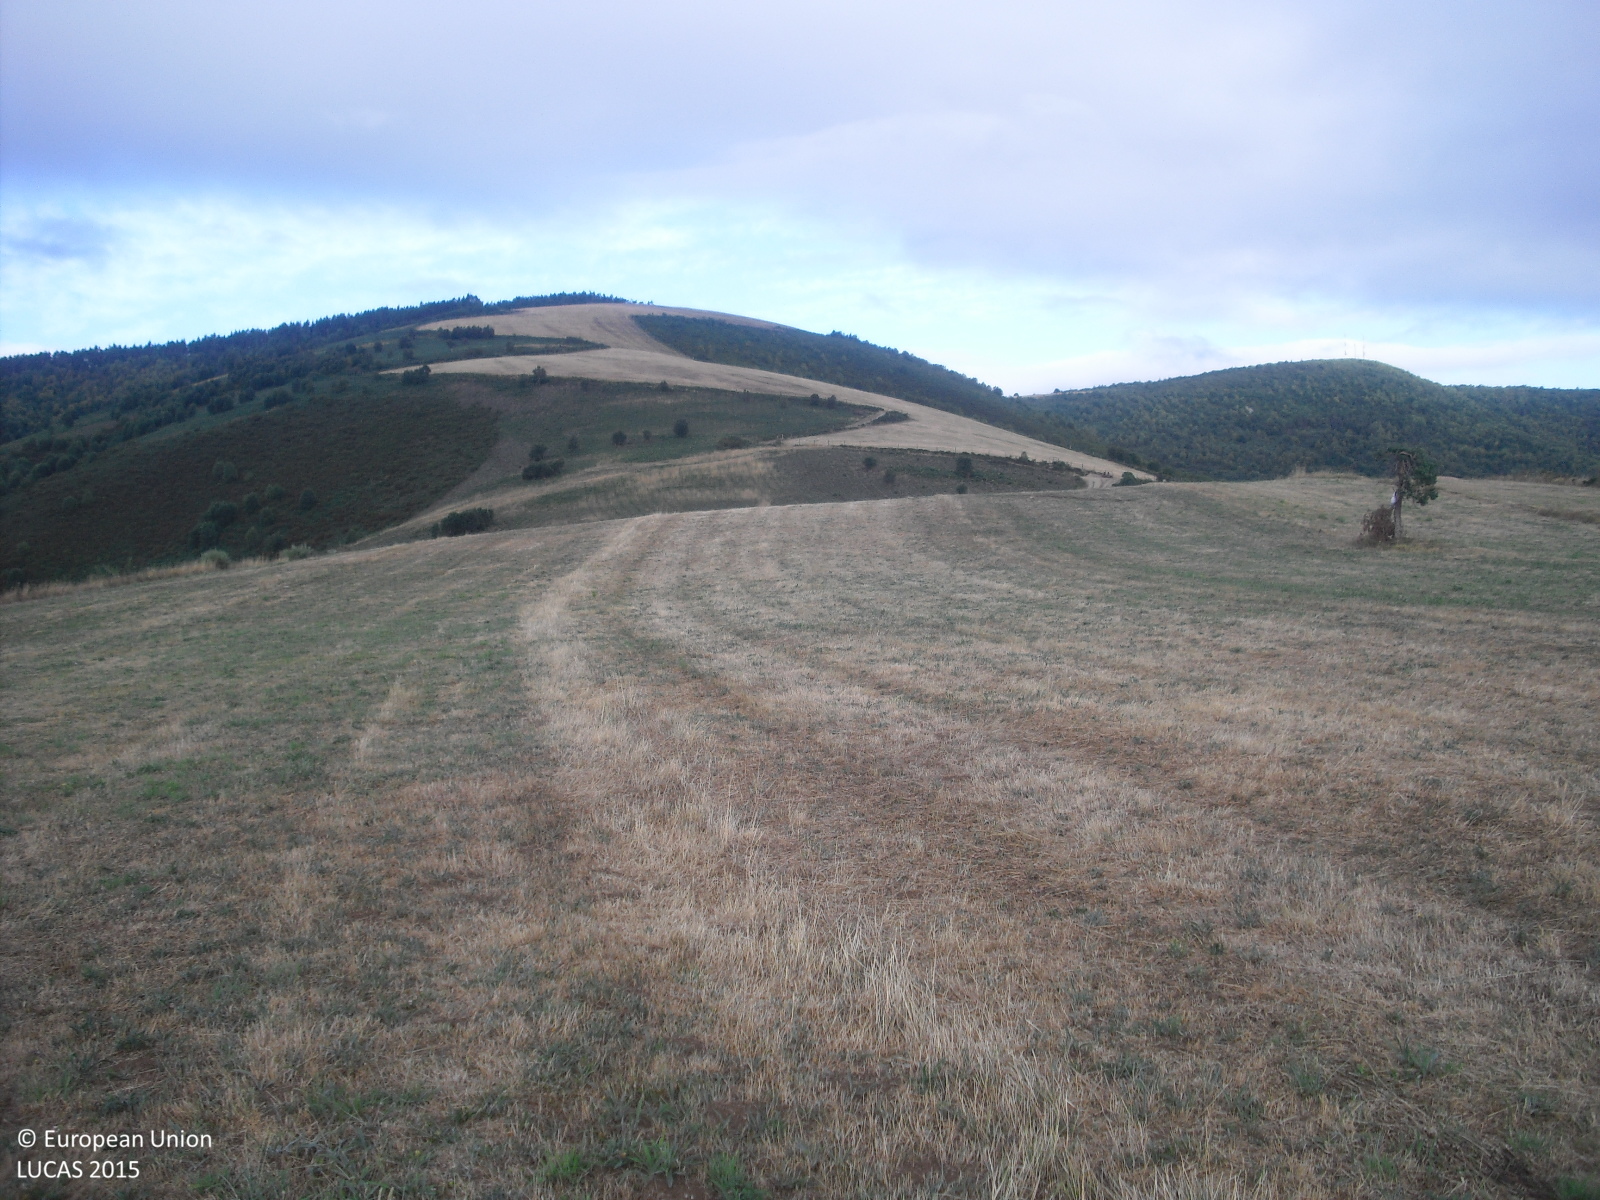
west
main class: Cropland
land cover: Temporary grasslands
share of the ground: > 75 %
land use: Agriculture (excluding fallow land and kitchen gardens)
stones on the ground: < 10 %
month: July
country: ES
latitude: 42.7381
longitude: -7.0764
